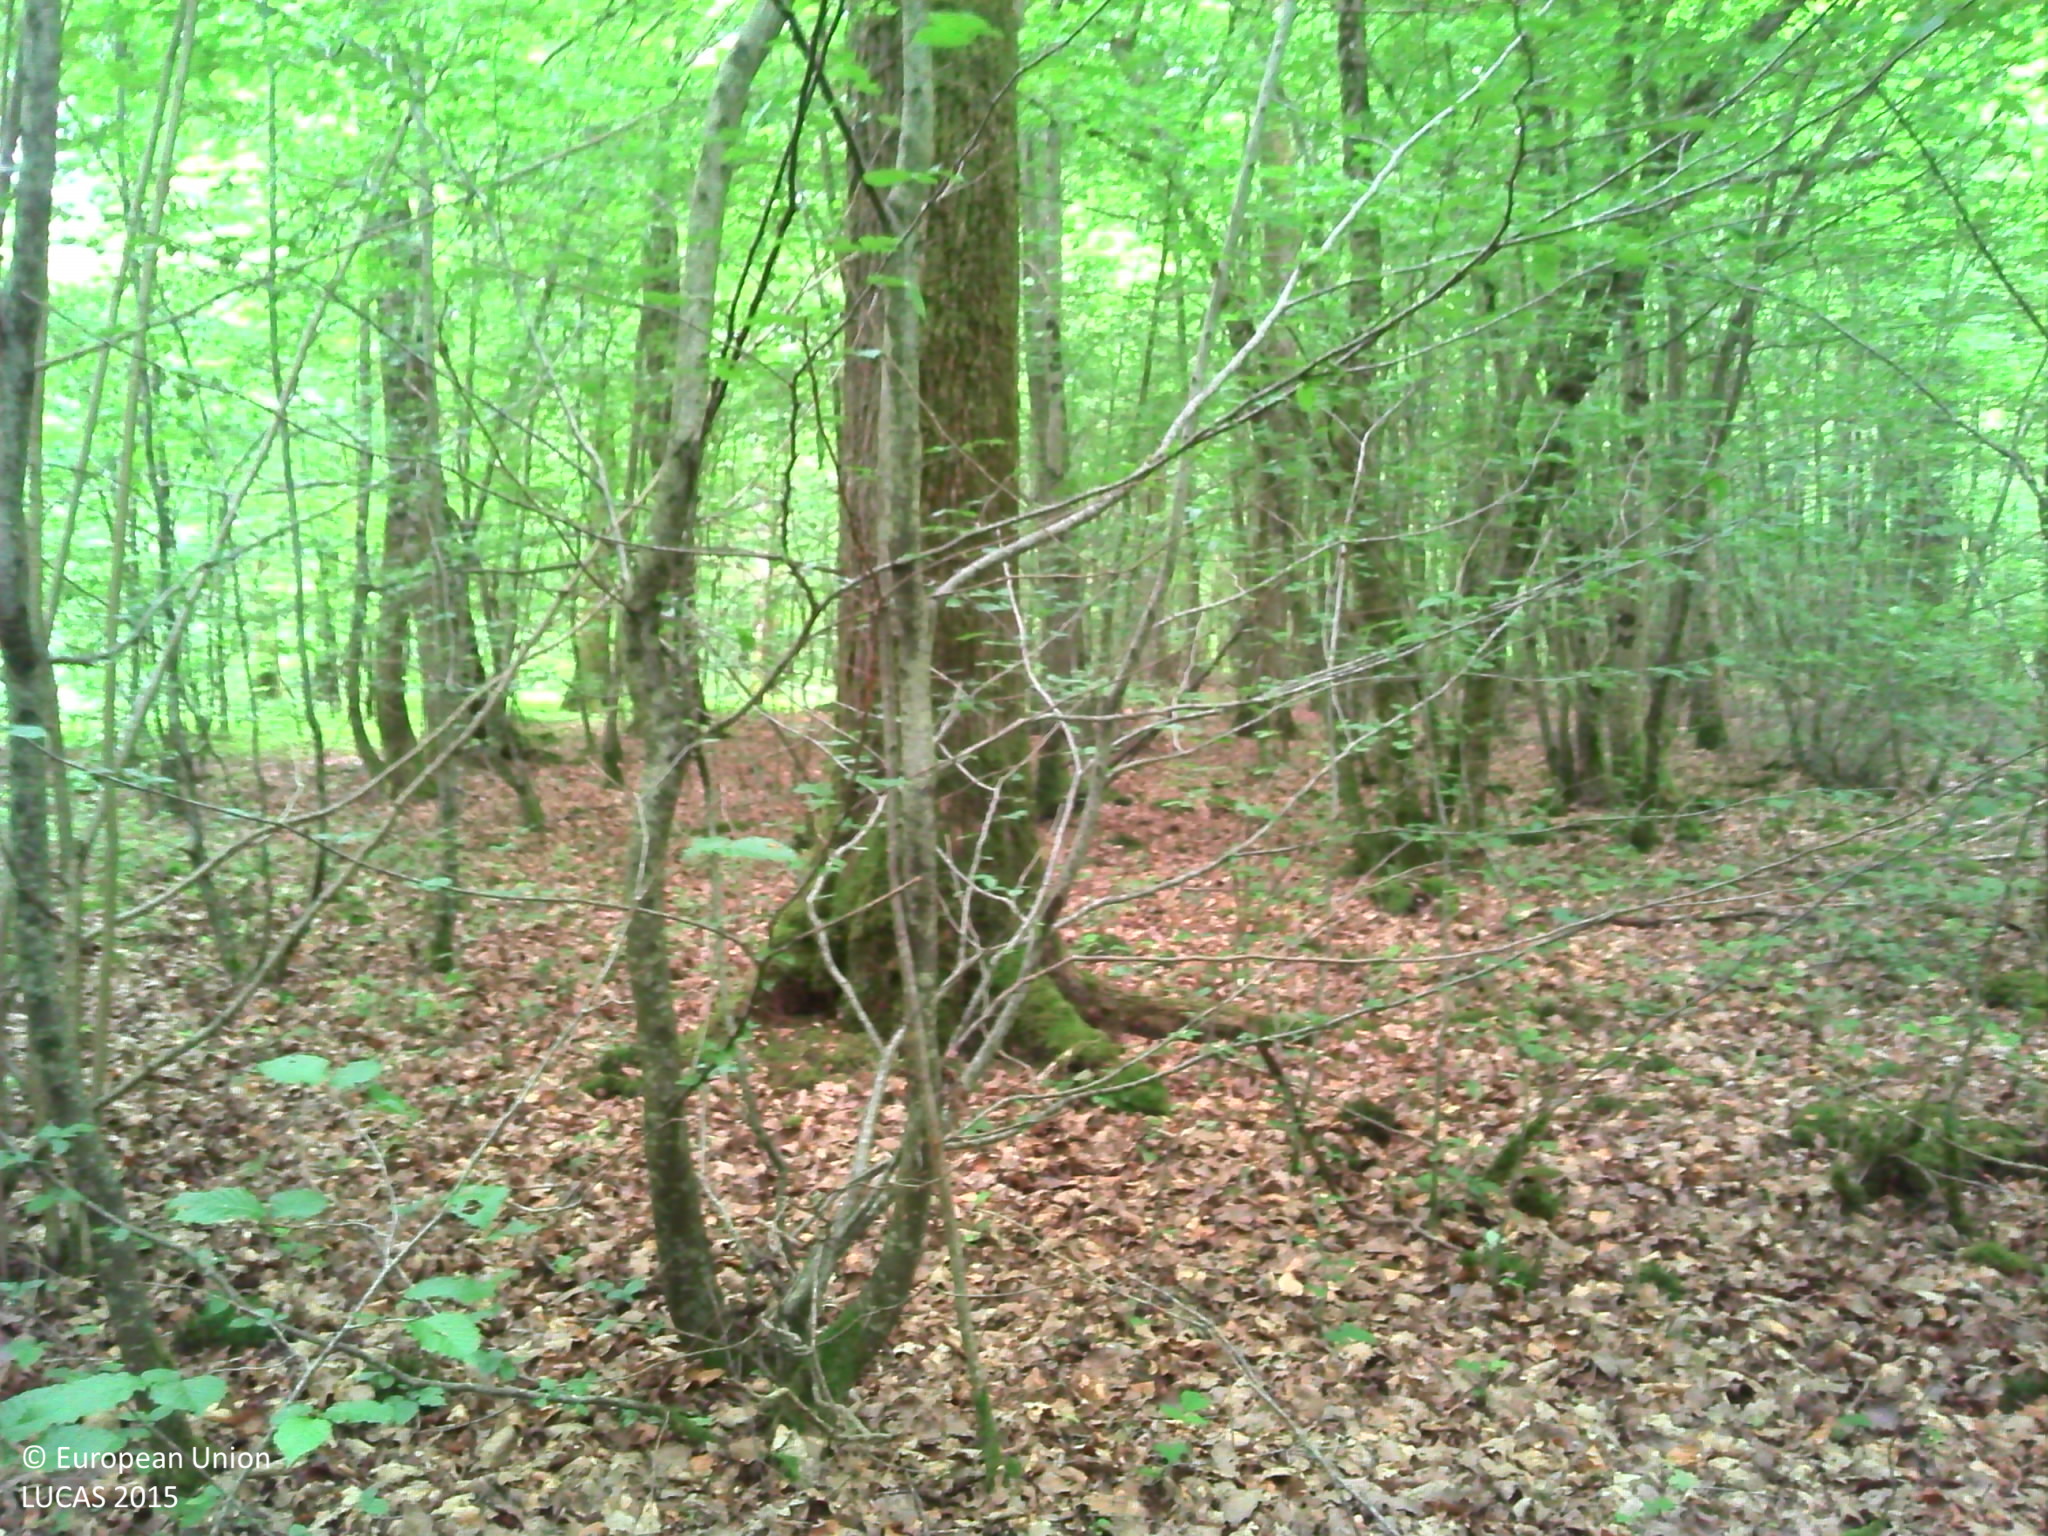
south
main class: Woodland
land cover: Broadleaved woodland
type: mesophytic deciduous forest
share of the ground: > 75 %
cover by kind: broadleaved forest trees 90 %, herbaceous plants 10 %
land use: Forestry
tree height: > 5 m
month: June
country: FR
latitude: 48.5020
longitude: 4.8958
